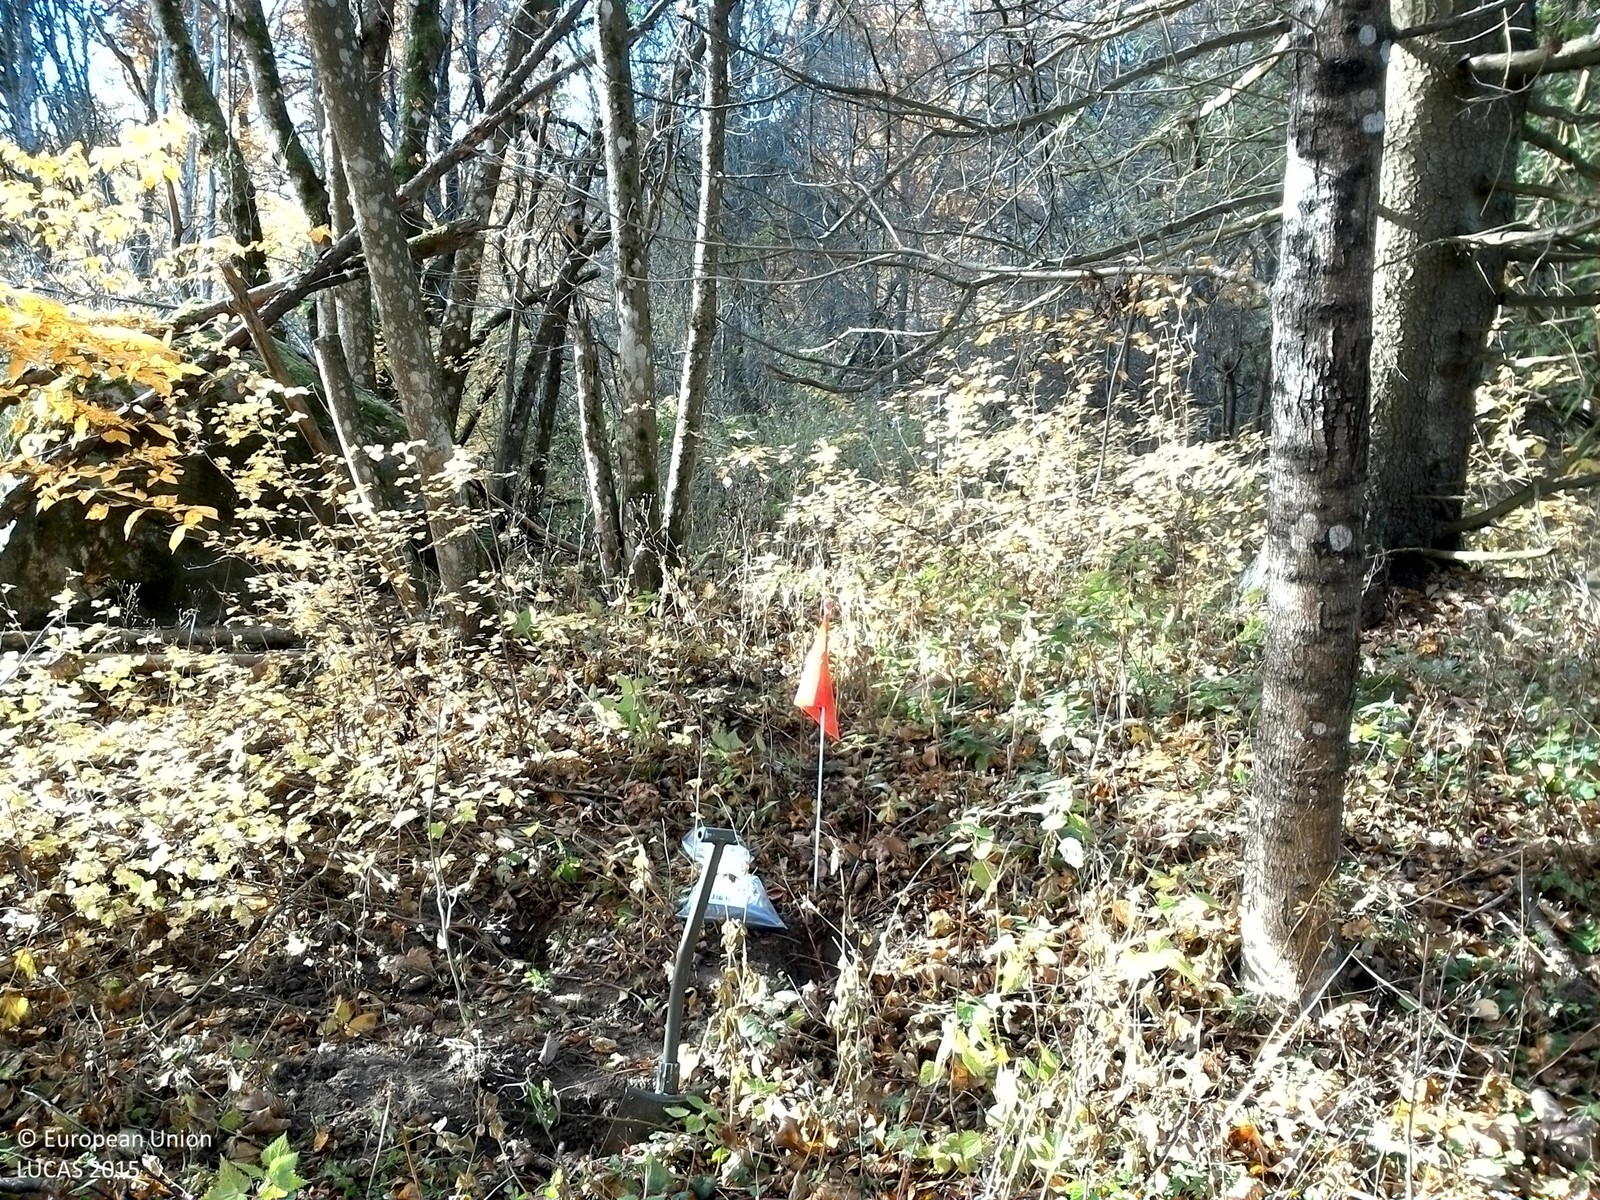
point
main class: Woodland
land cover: Broadleaved woodland
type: hemiboreal forest and nemoral coniferous forest and mixed broadleaved-coniferous forest
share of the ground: > 75 %
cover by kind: broadleaved forest trees 75 %, shrubs 10 %, herbaceous plants 10 %, consolidated bare surface 5 %
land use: Forestry
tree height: > 5 m
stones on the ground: < 10 %
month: October
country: SE
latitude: 59.4428
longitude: 16.3231
